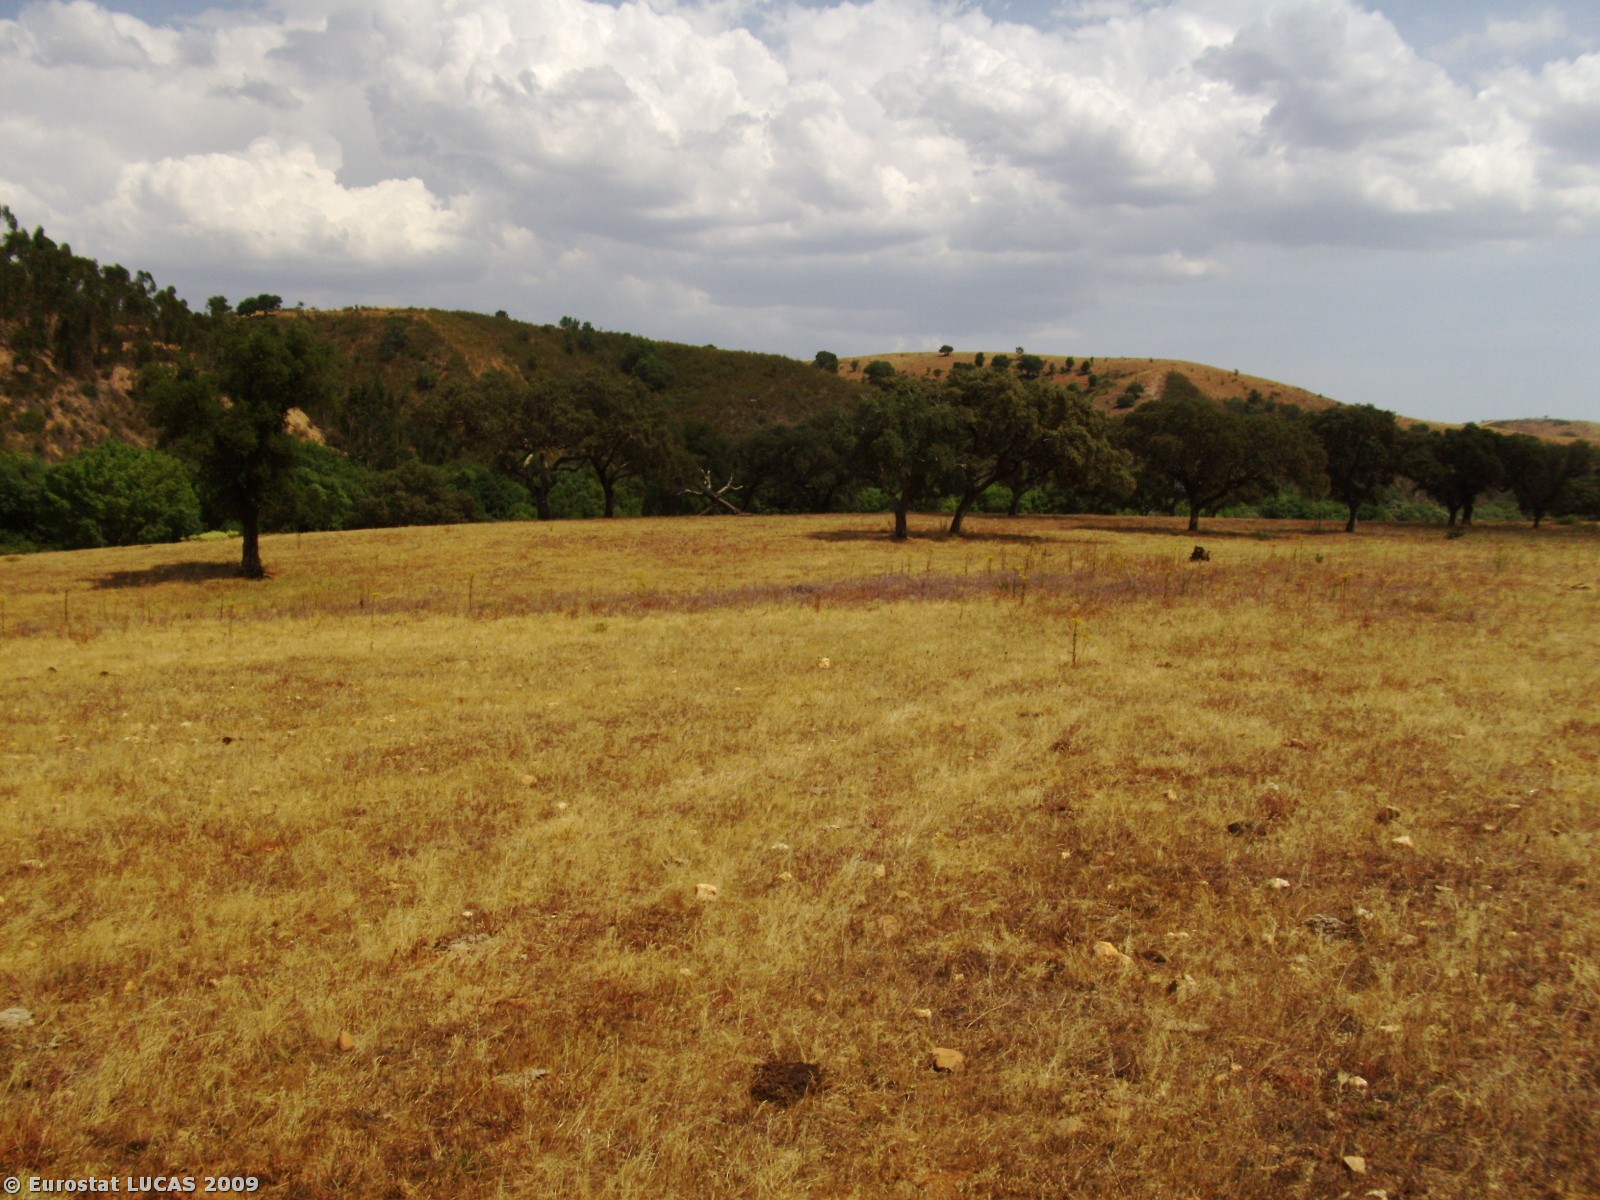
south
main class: Woodland
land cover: Broadleaved woodland
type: broadleaved evergreen forest
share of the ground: 10 - 25 %
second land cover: Spontaneously vegetated surfaces
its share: 50 - 75 %
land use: Forestry
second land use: Fallow land
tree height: > 5 m
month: June
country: PT
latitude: 37.5167
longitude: -8.5553
